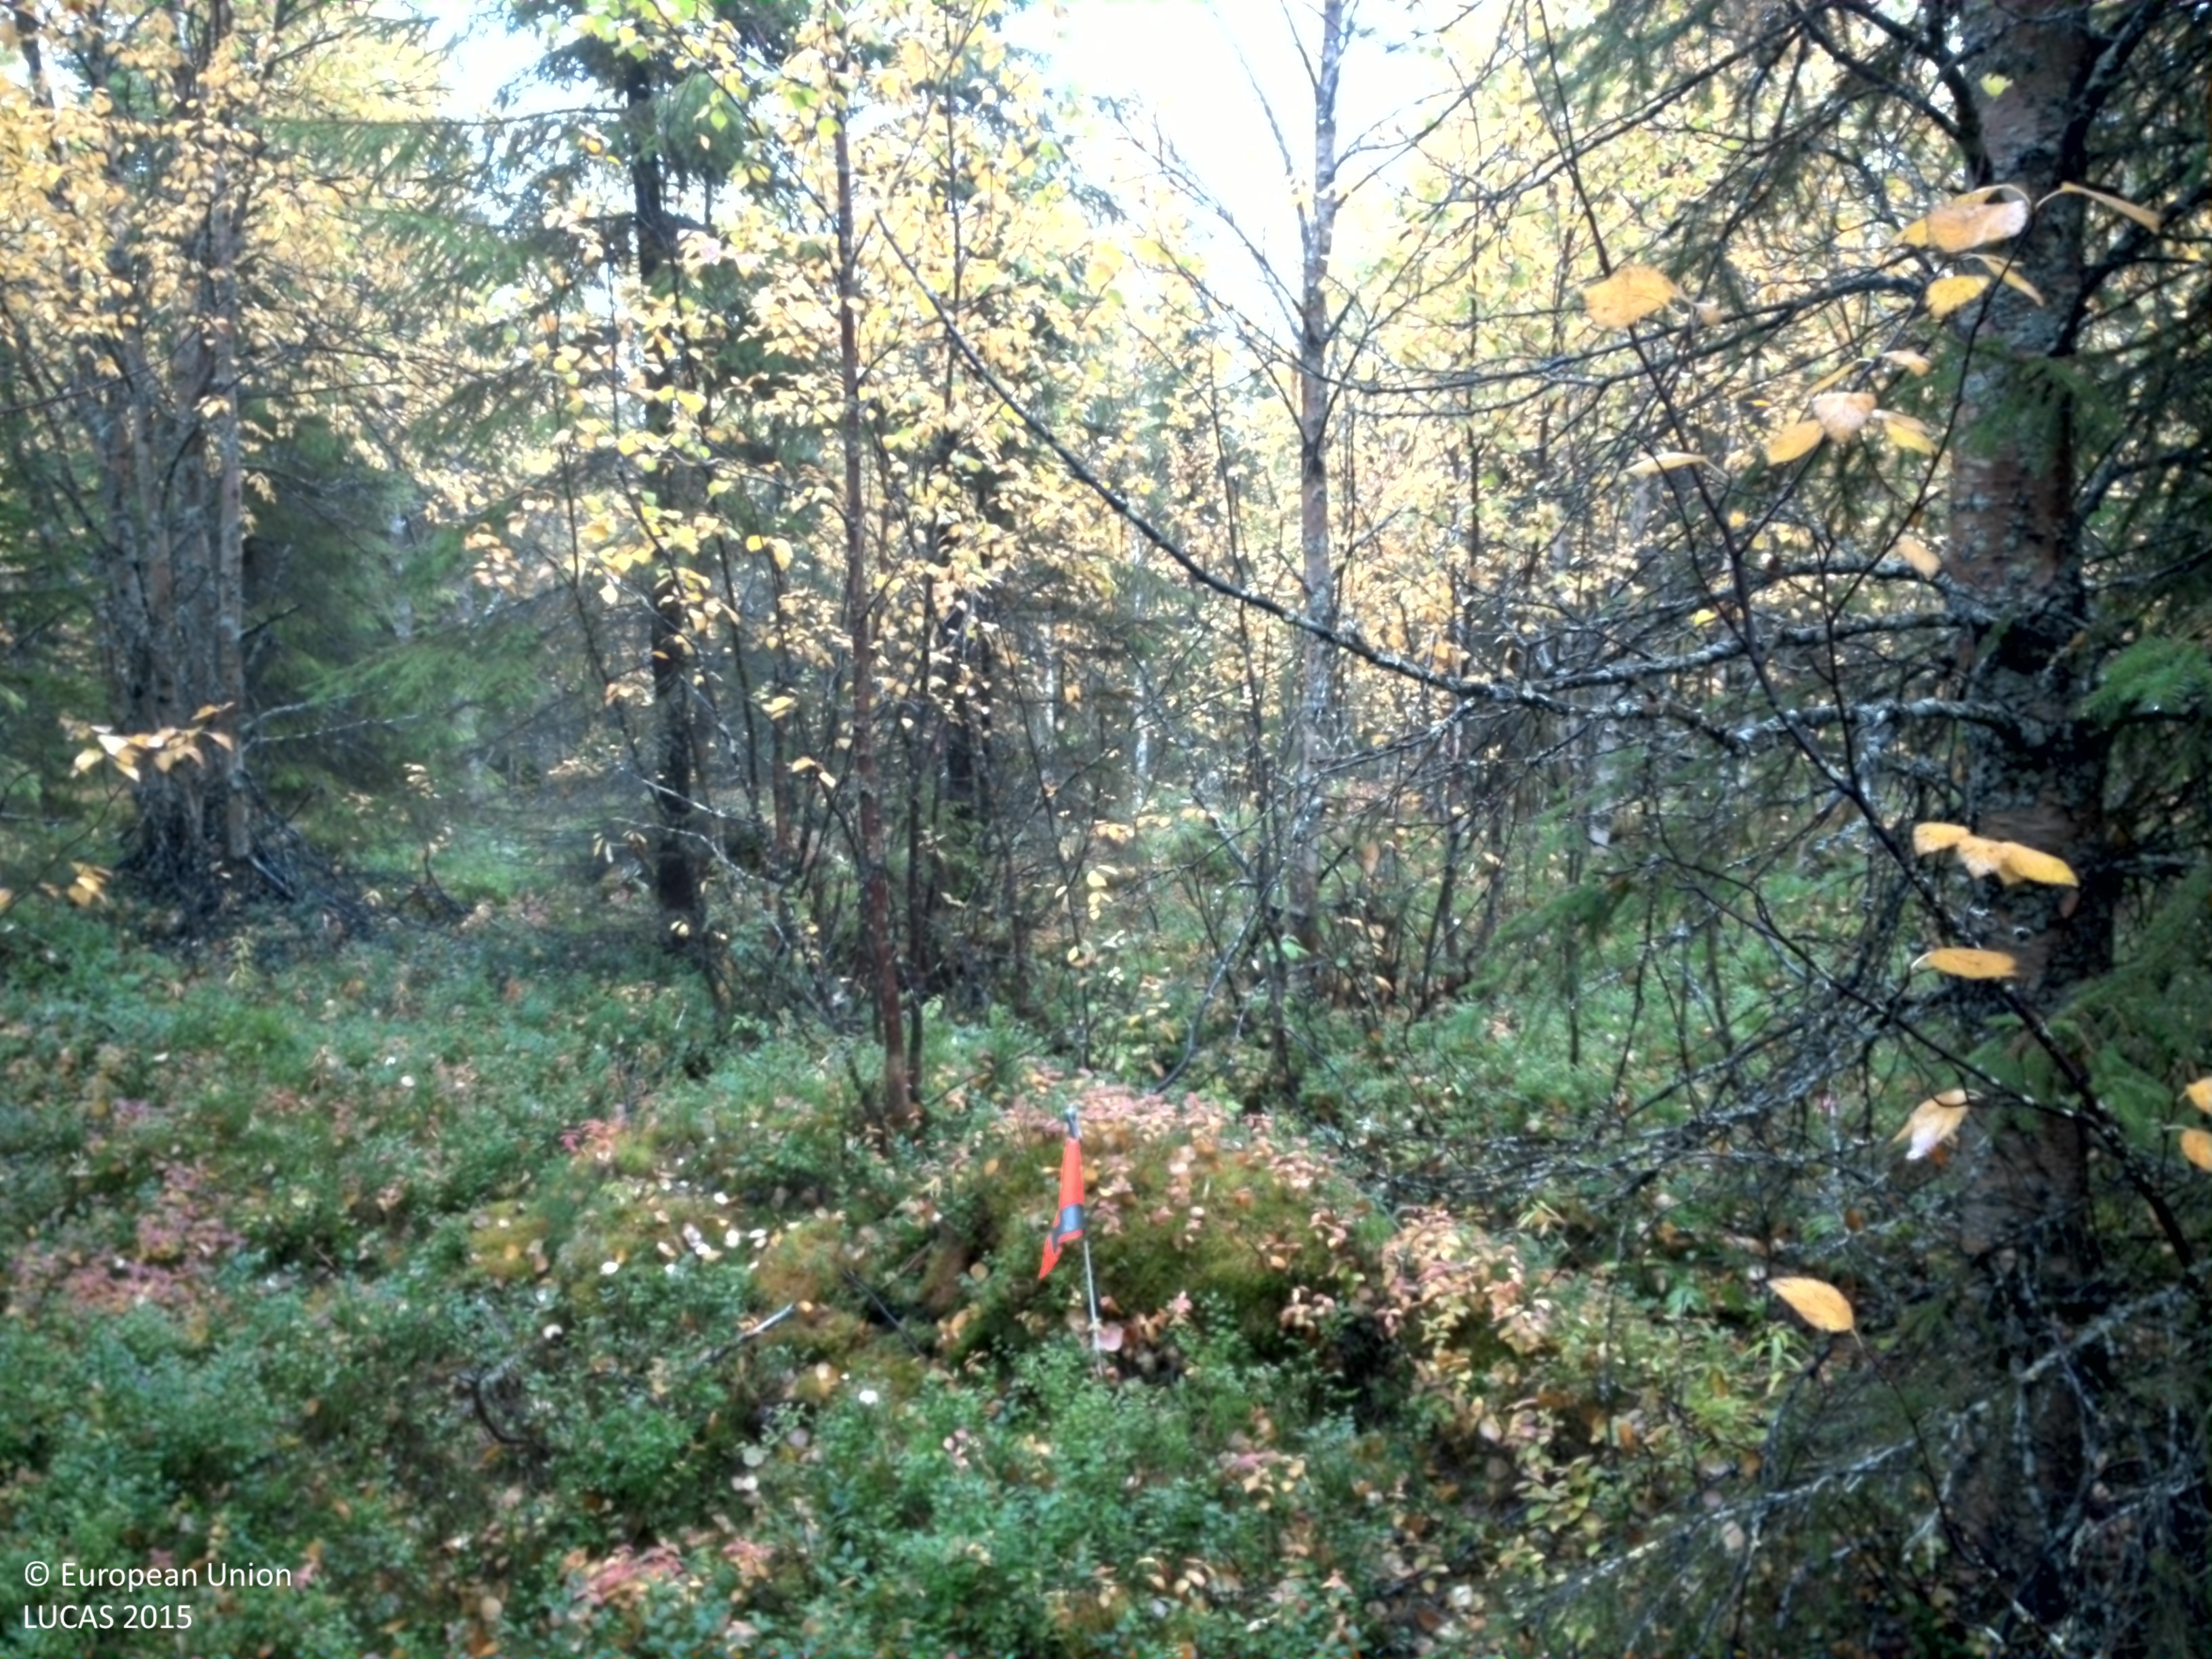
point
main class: Woodland
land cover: Spruce dominated mixed woodland
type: boreal forest
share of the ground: 50 - 75 %
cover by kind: coniferous forest trees 40 %, shrubs 25 %, broadleaved forest trees 20 %, herbaceous plants 10 %, lichens and mosses 5 %
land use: Forestry
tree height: > 5 m
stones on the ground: < 10 %
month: September
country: SE
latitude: 65.2332
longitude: 16.3174
